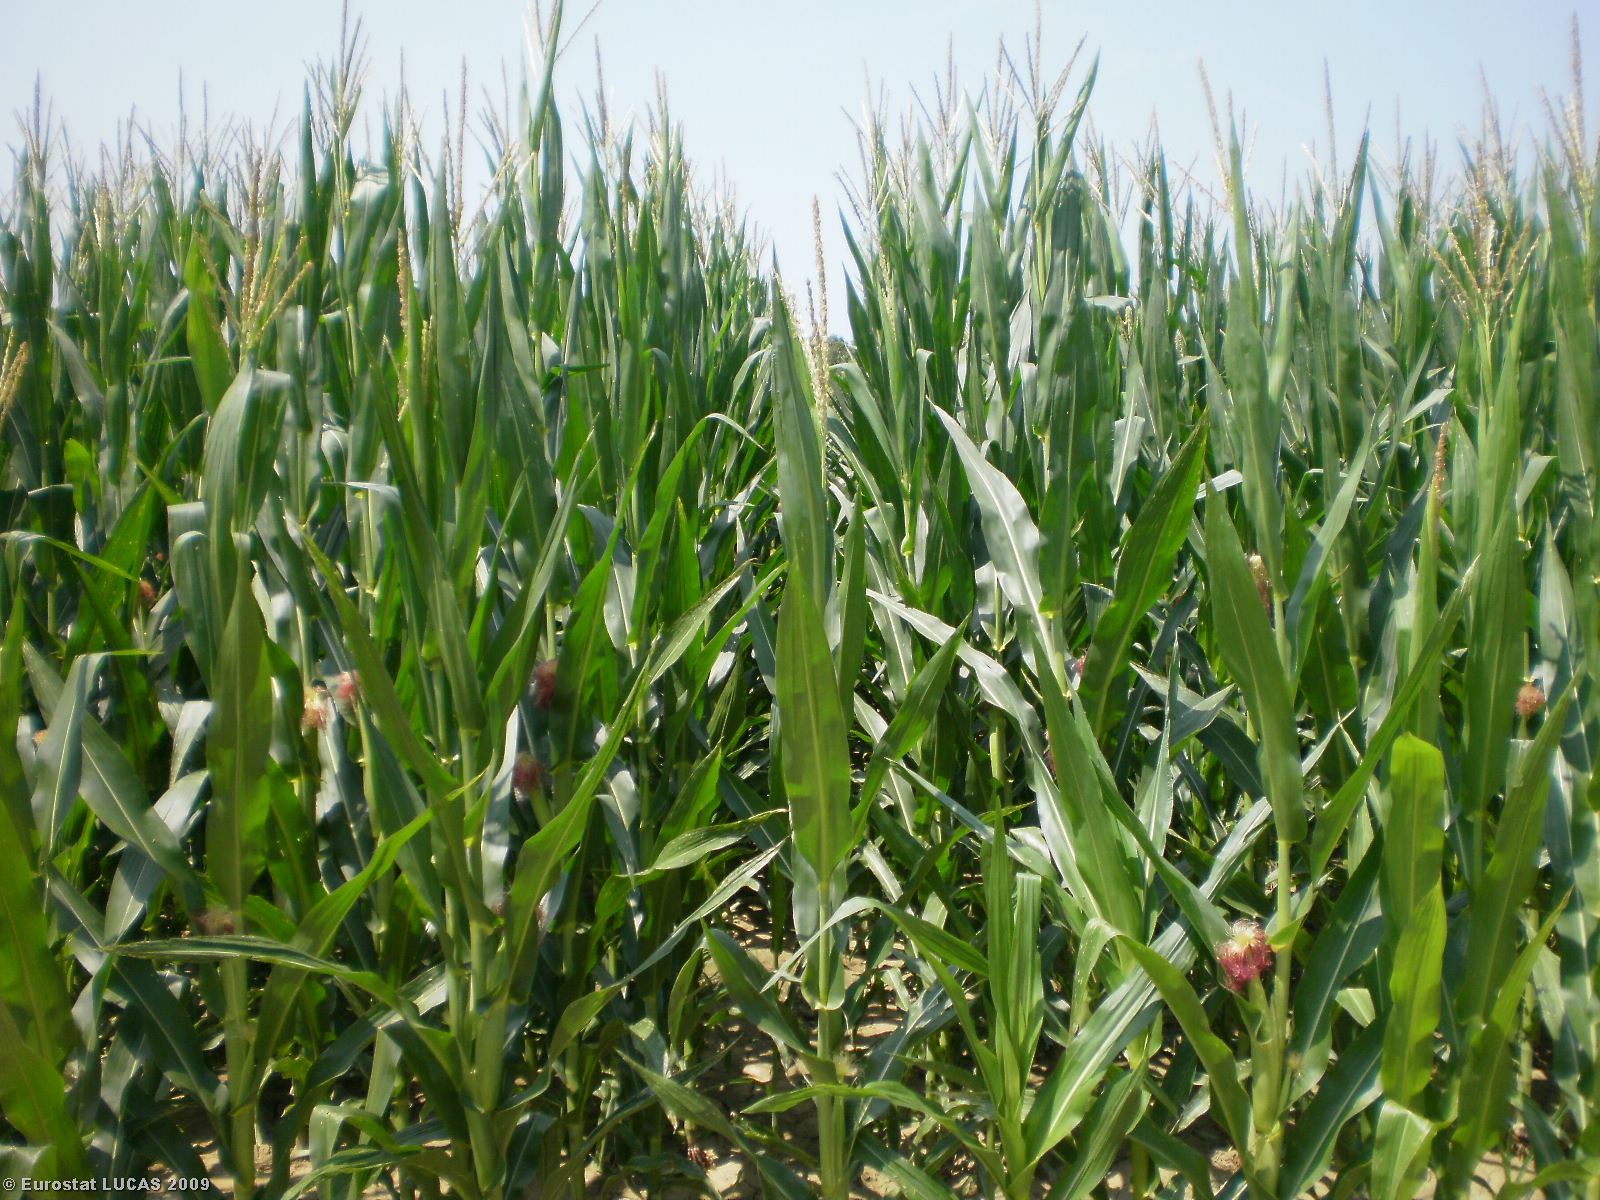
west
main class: Cropland
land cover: Maize
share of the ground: > 75 %
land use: Agriculture (excluding fallow land and kitchen gardens)
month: June
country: IT
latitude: 45.2340
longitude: 10.0381
